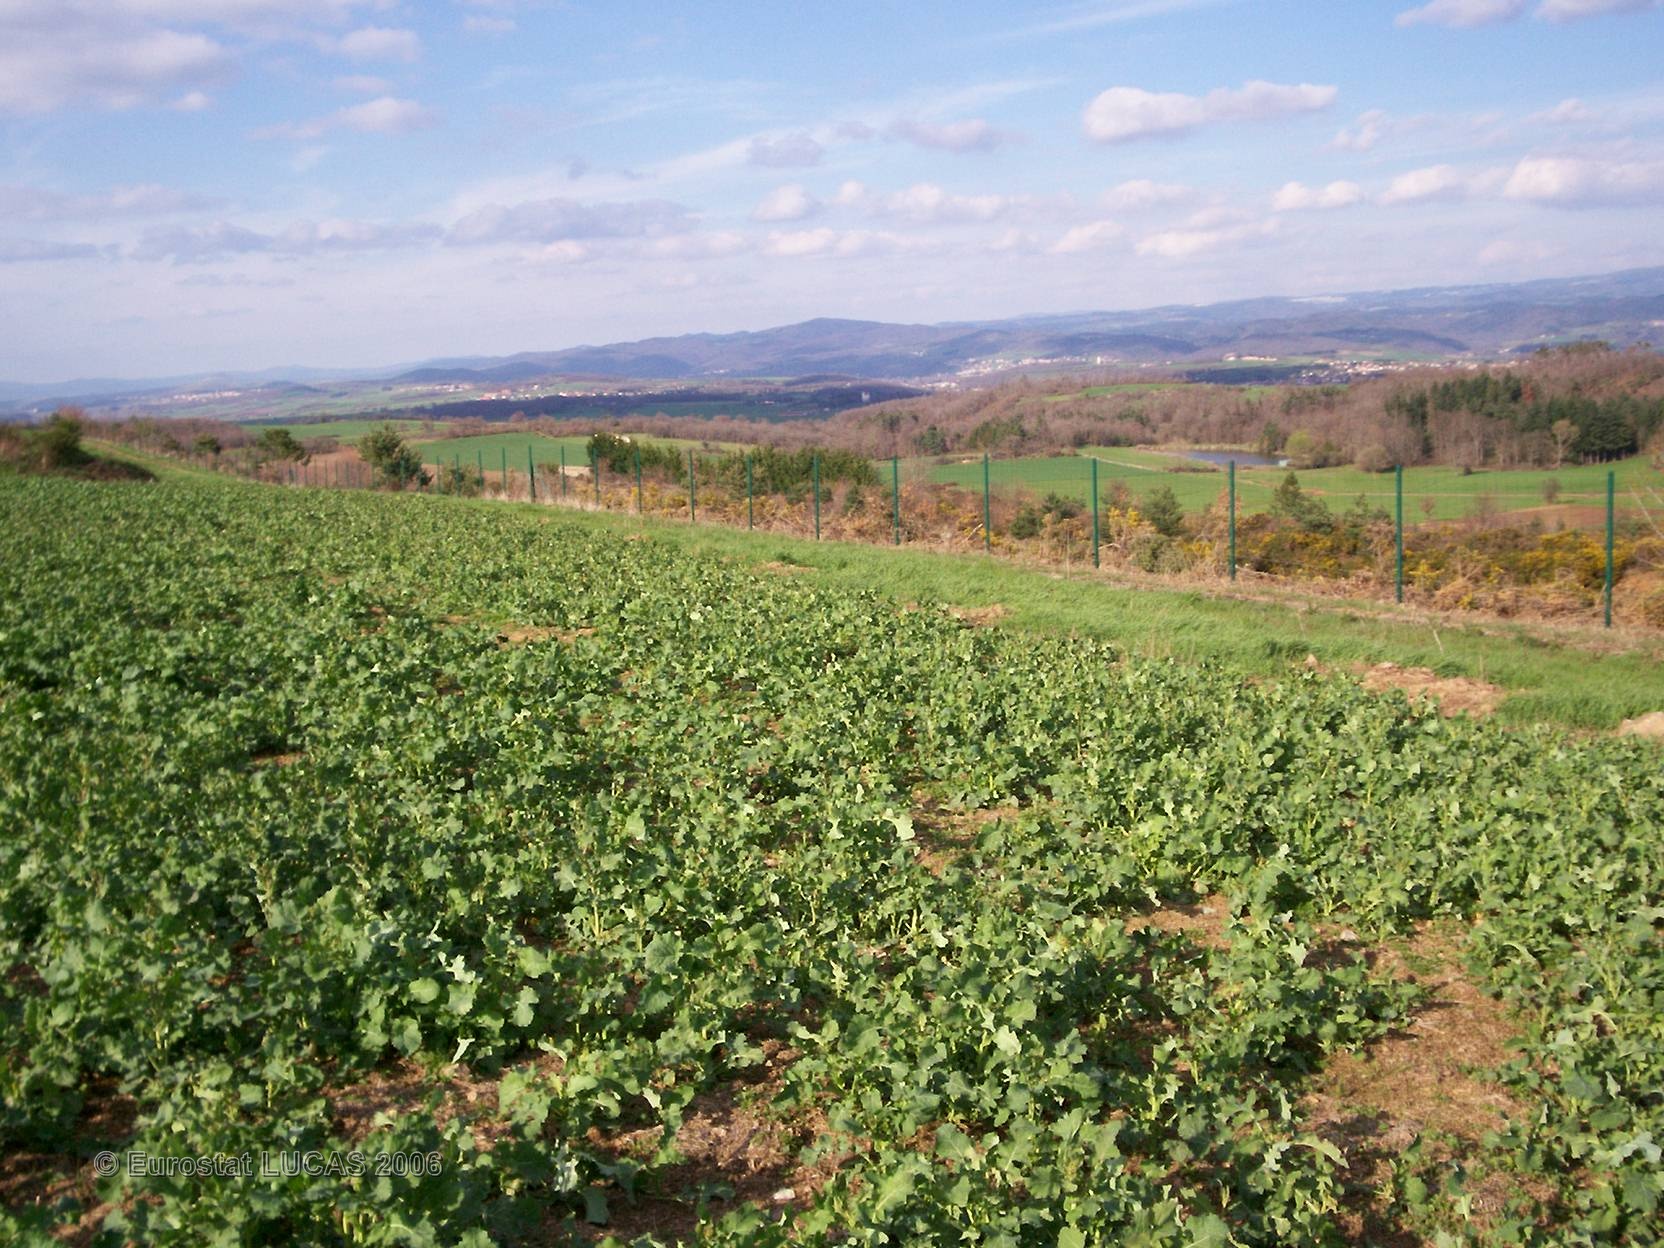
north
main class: Cropland
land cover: Rape and turnip rape
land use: Agriculture (excluding fallow land and kitchen gardens)
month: April
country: FR
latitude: 45.3442
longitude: 3.2759
